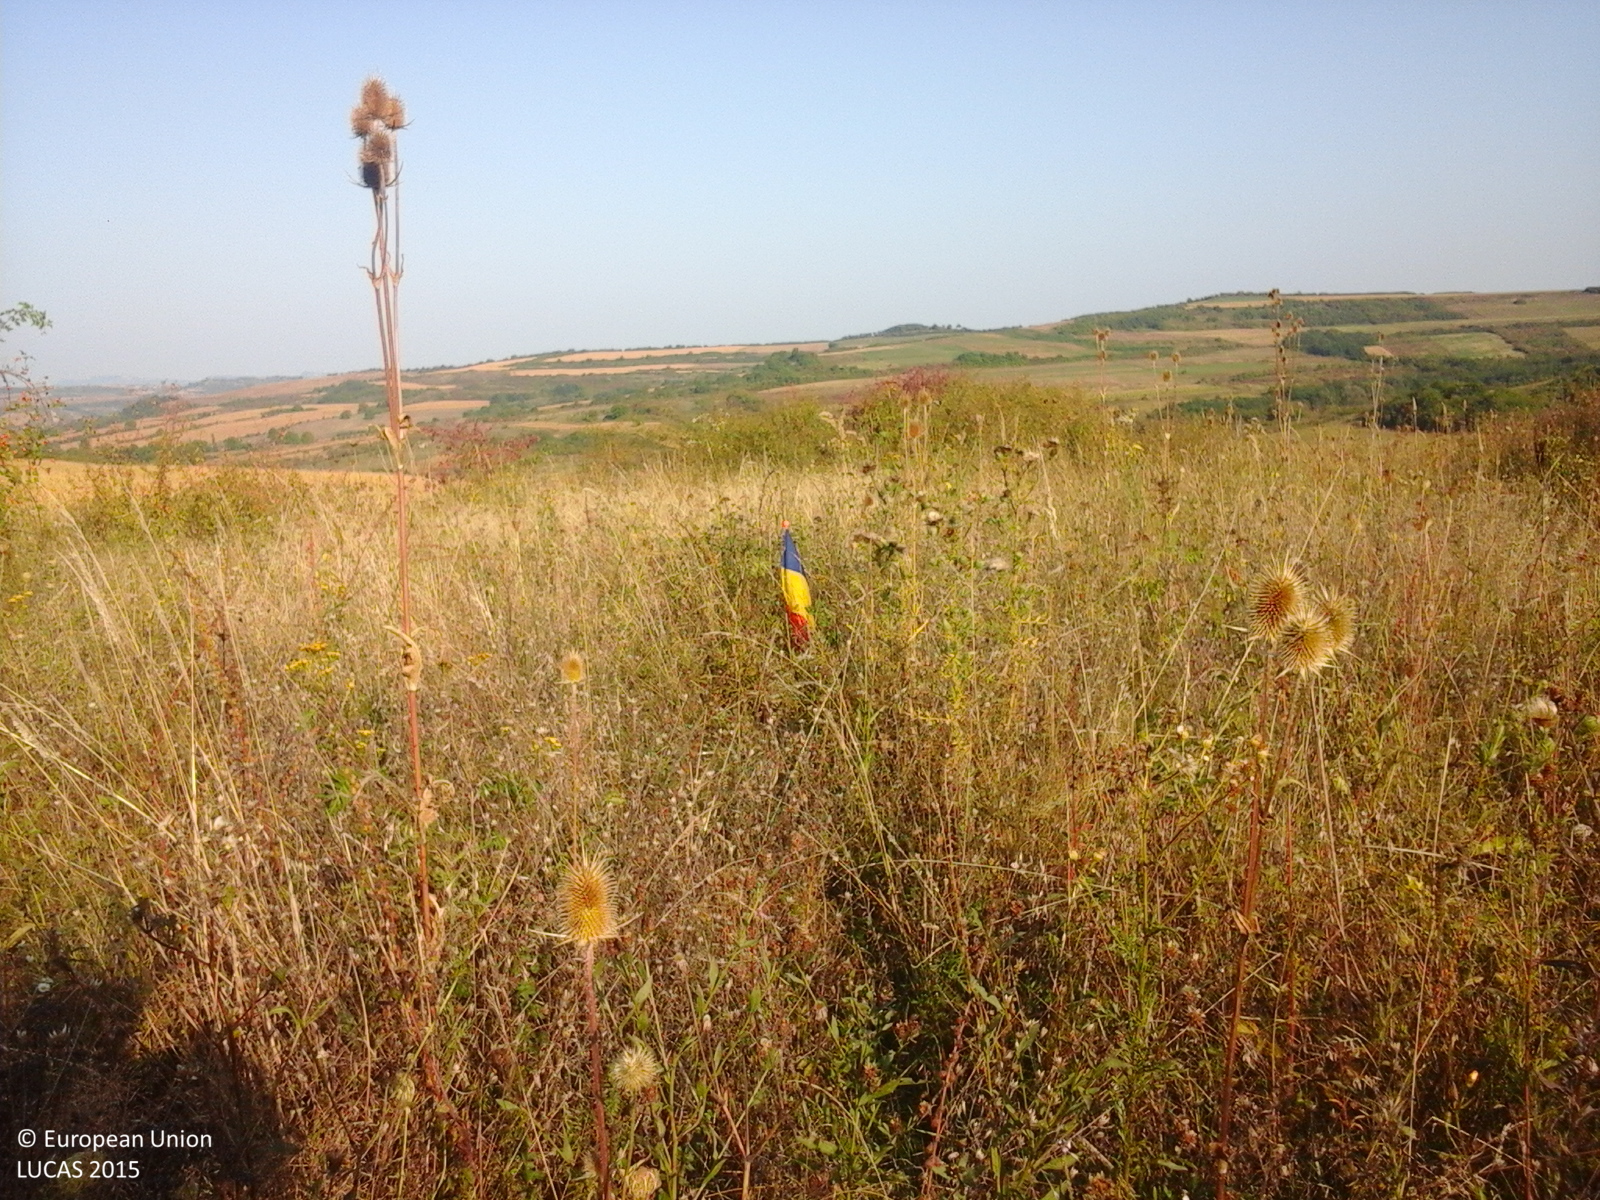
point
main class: Grassland
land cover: Spontaneously vegetated surfaces
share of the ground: > 75 %
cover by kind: herbaceous plants 100 %
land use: Fallow land
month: September
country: RO
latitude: 47.3139
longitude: 23.0689
